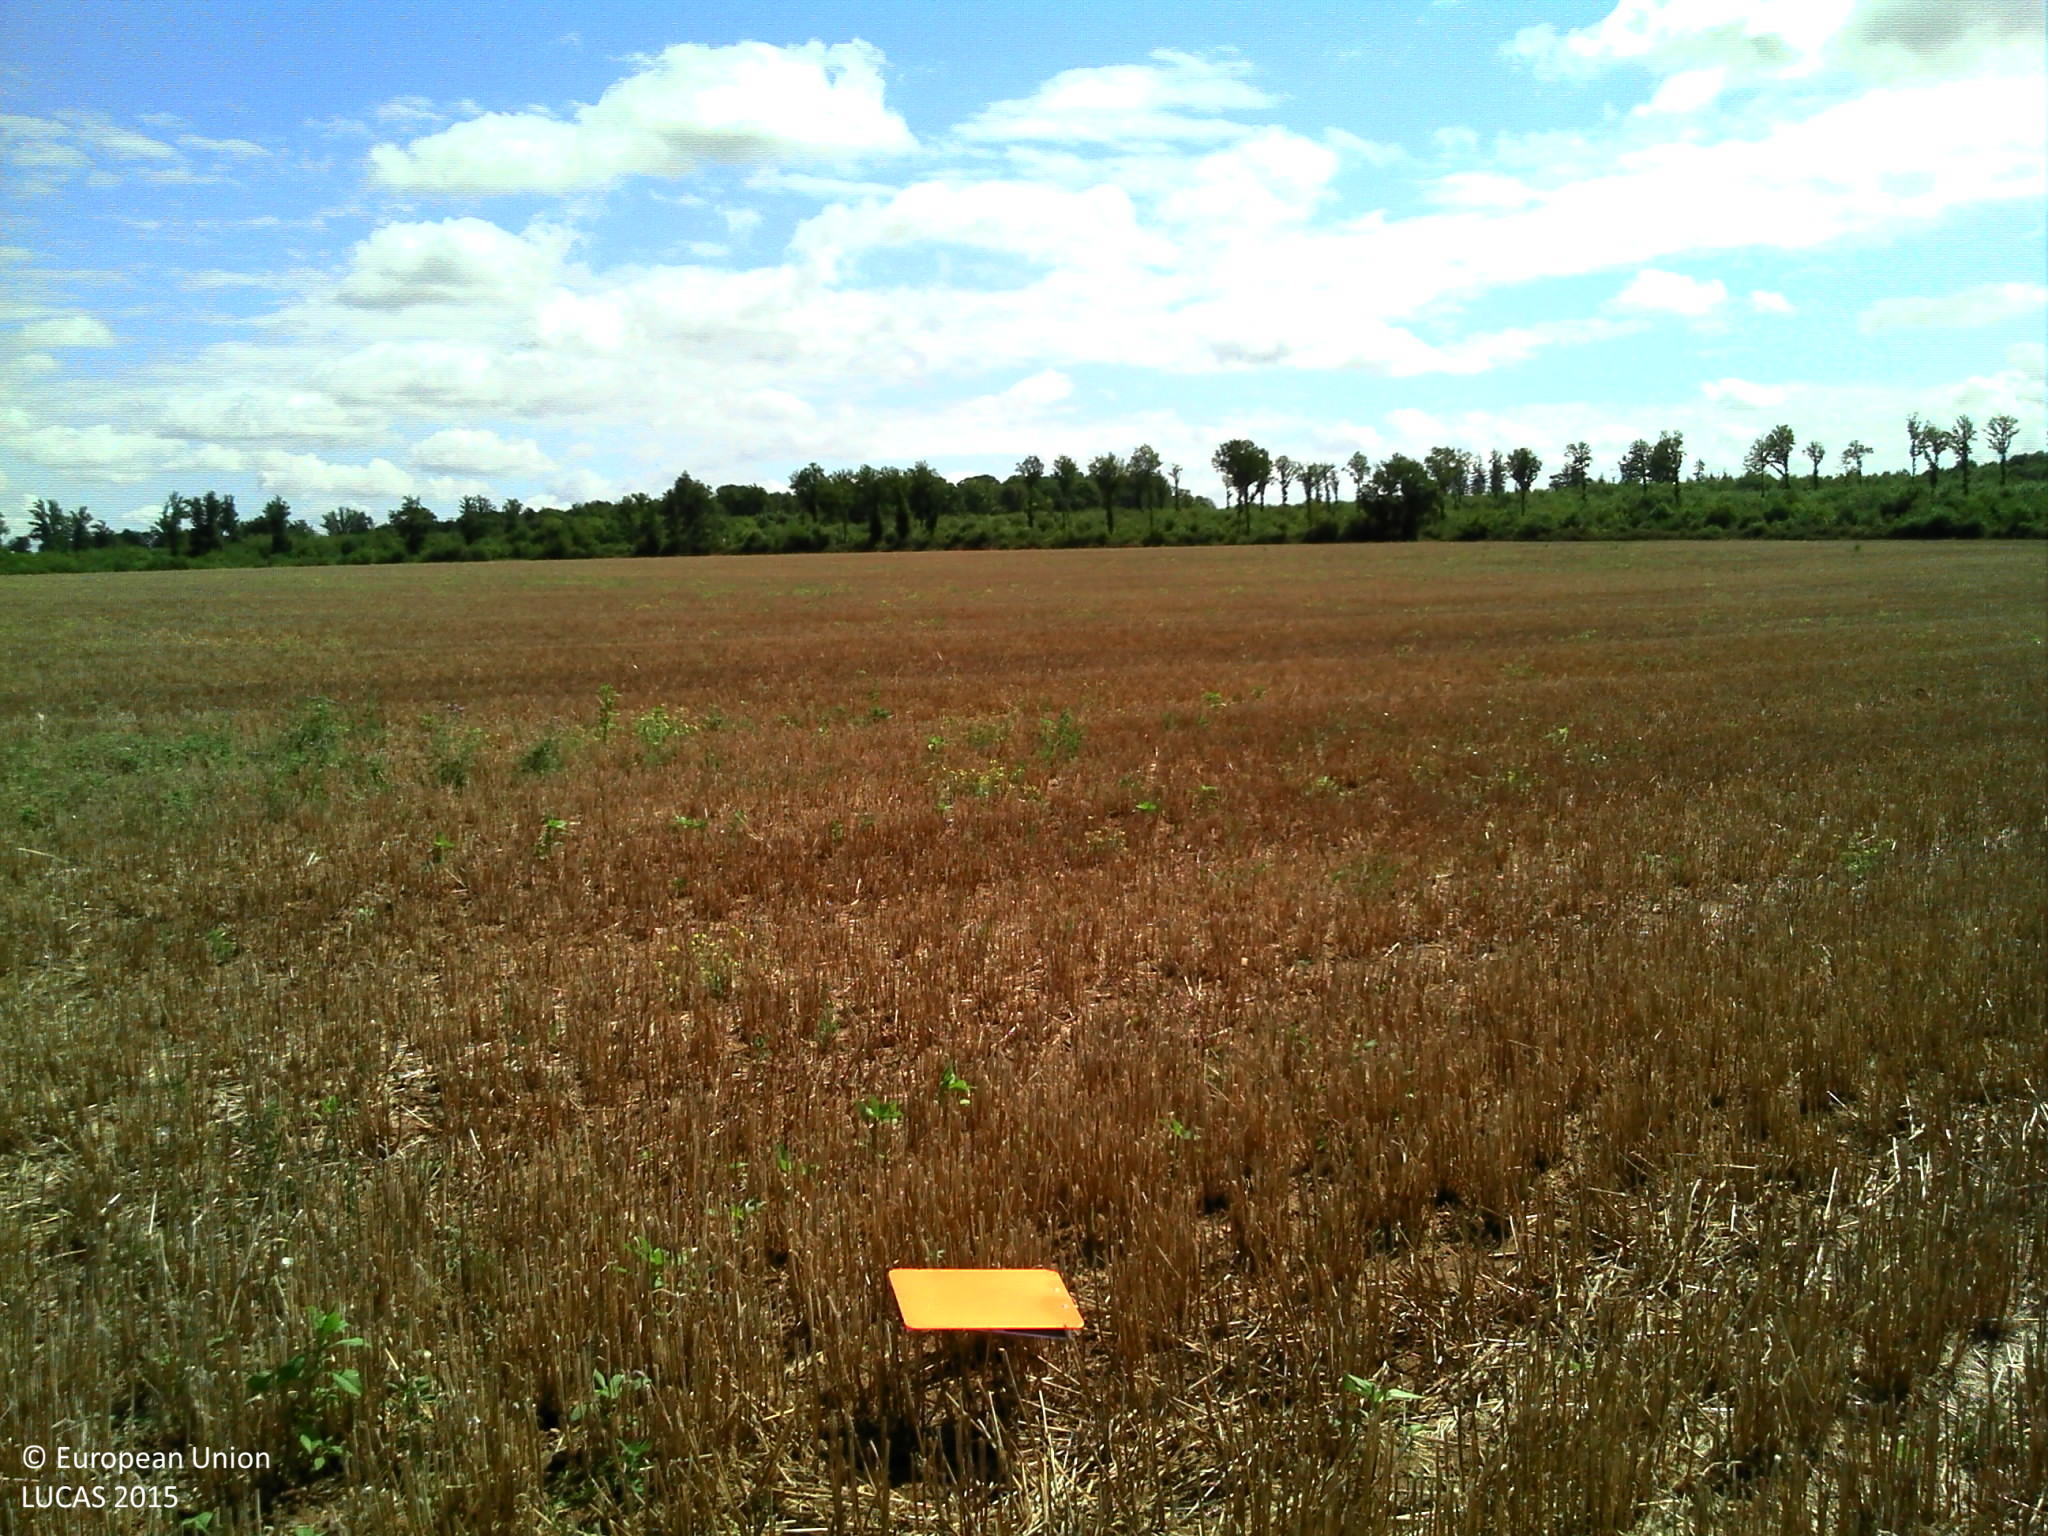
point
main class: Cropland
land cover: Barley
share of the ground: 50 - 75 %
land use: Agriculture (excluding fallow land and kitchen gardens)
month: August
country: FR
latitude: 46.0950
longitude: 0.3468
